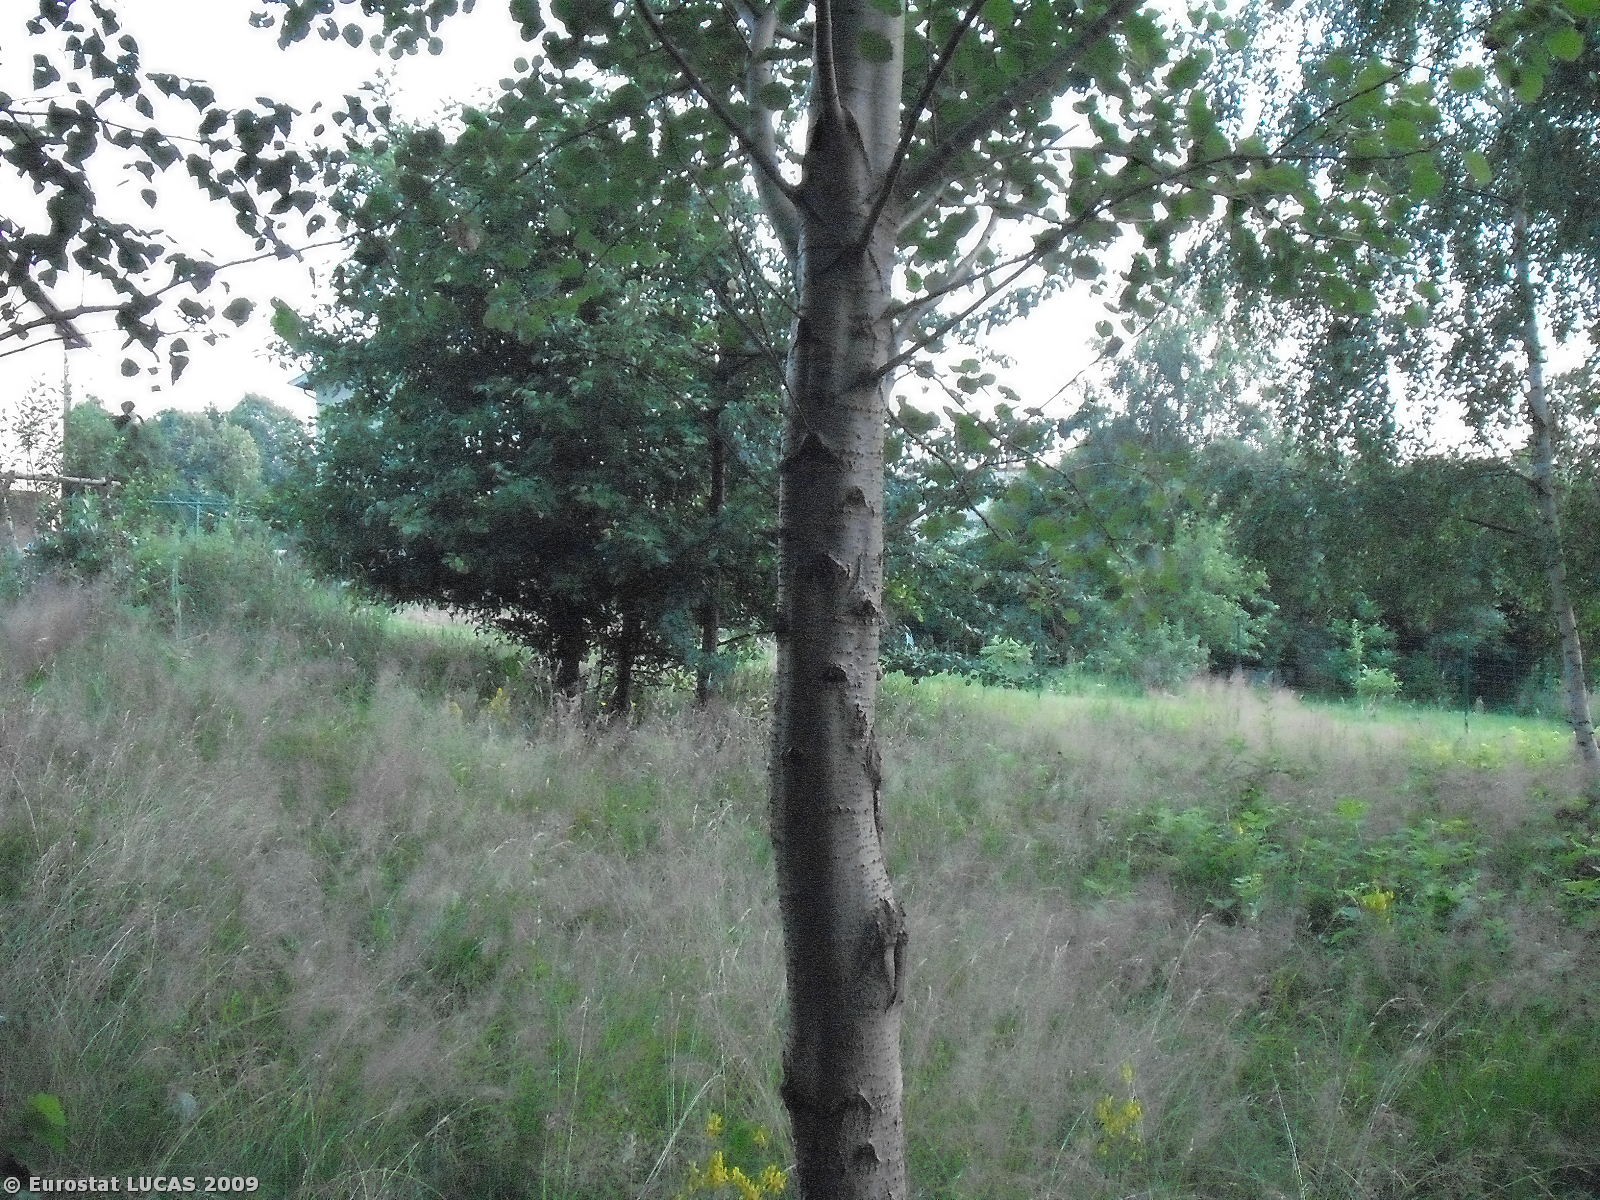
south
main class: Woodland
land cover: Broadleaved woodland
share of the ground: > 75 %
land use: Unused
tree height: > 5 m
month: July
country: PL
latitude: 50.9943
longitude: 20.7991
